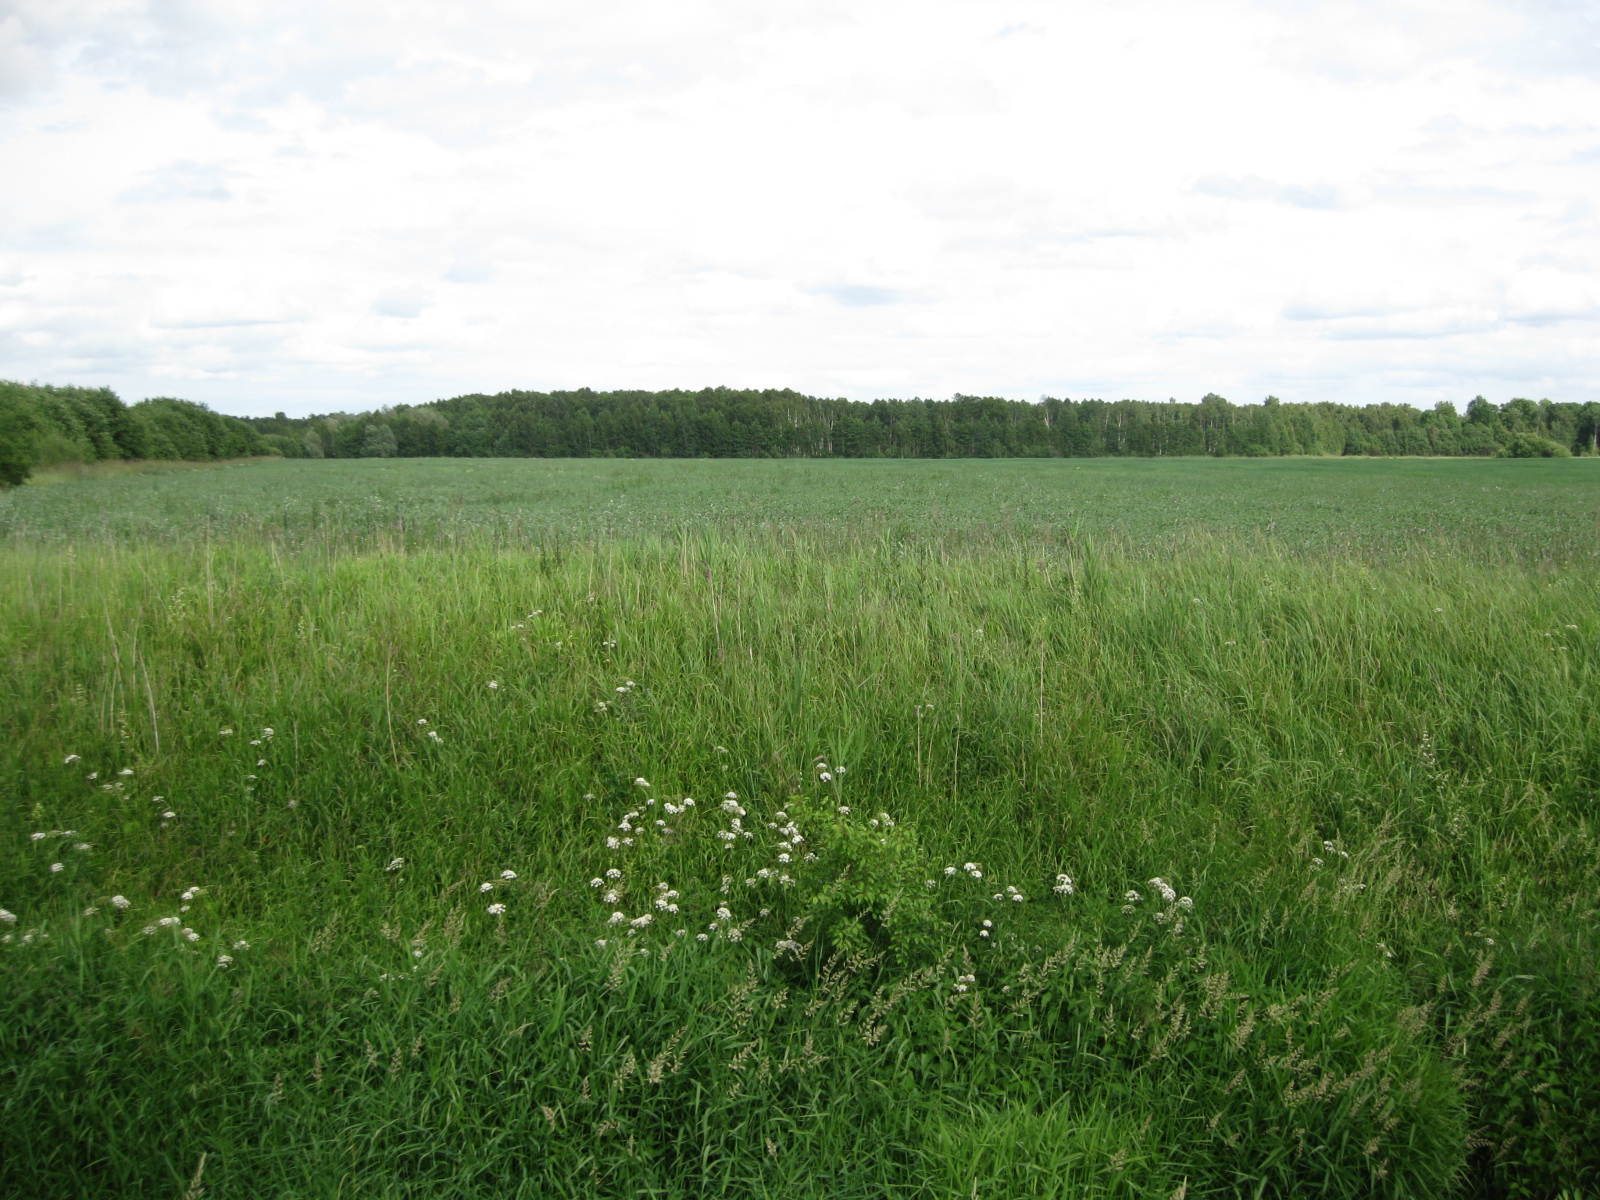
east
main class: Cropland
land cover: Dry pulses
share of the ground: > 75 %
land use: Agriculture (excluding fallow land and kitchen gardens)
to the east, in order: Dry pulses
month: June
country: LT
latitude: 55.5478
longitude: 24.2807
